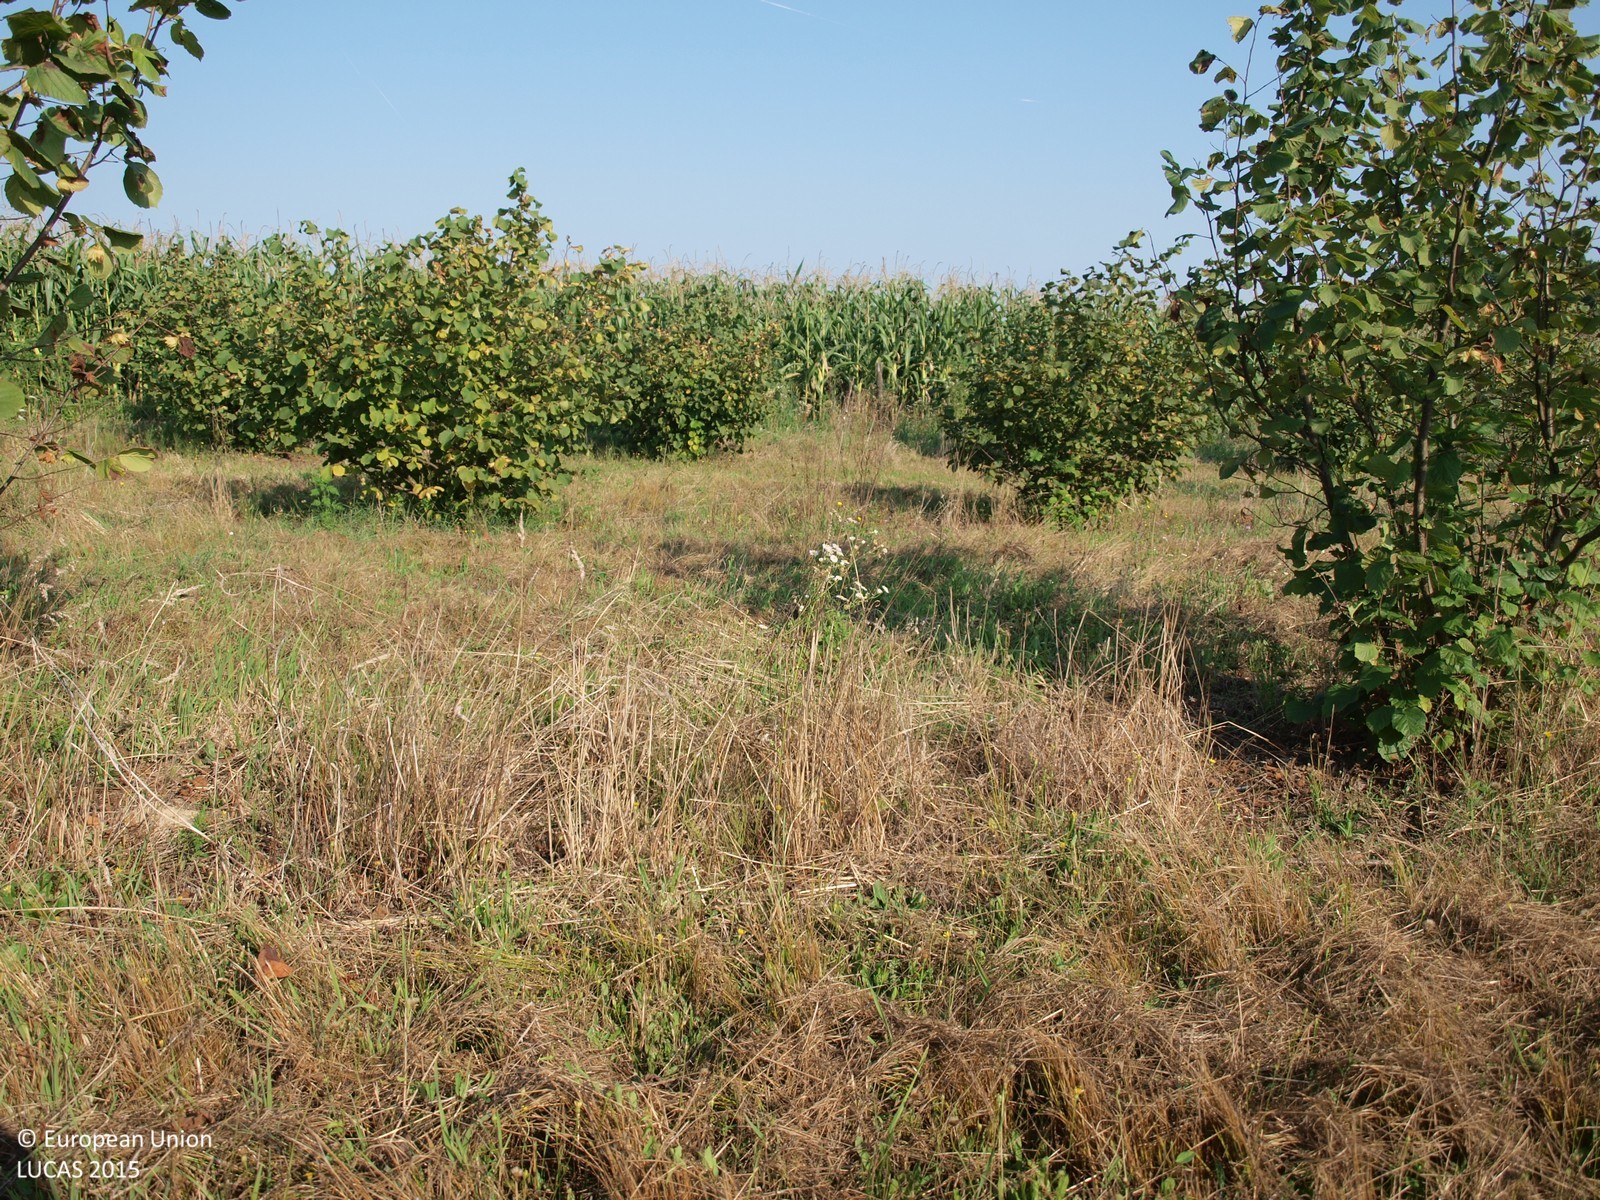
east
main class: Cropland
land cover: Nuts trees
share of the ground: 25 - 50 %
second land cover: Grassland without tree/shrub cover
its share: > 75 %
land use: Agriculture (excluding fallow land and kitchen gardens)
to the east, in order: Nuts trees; Grassland without tree/shrub cover; Fences; Maize; Grass margins; Maize; Grass margins; Maize; Tracks; Maize
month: August
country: HR
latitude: 45.8414
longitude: 16.5789
